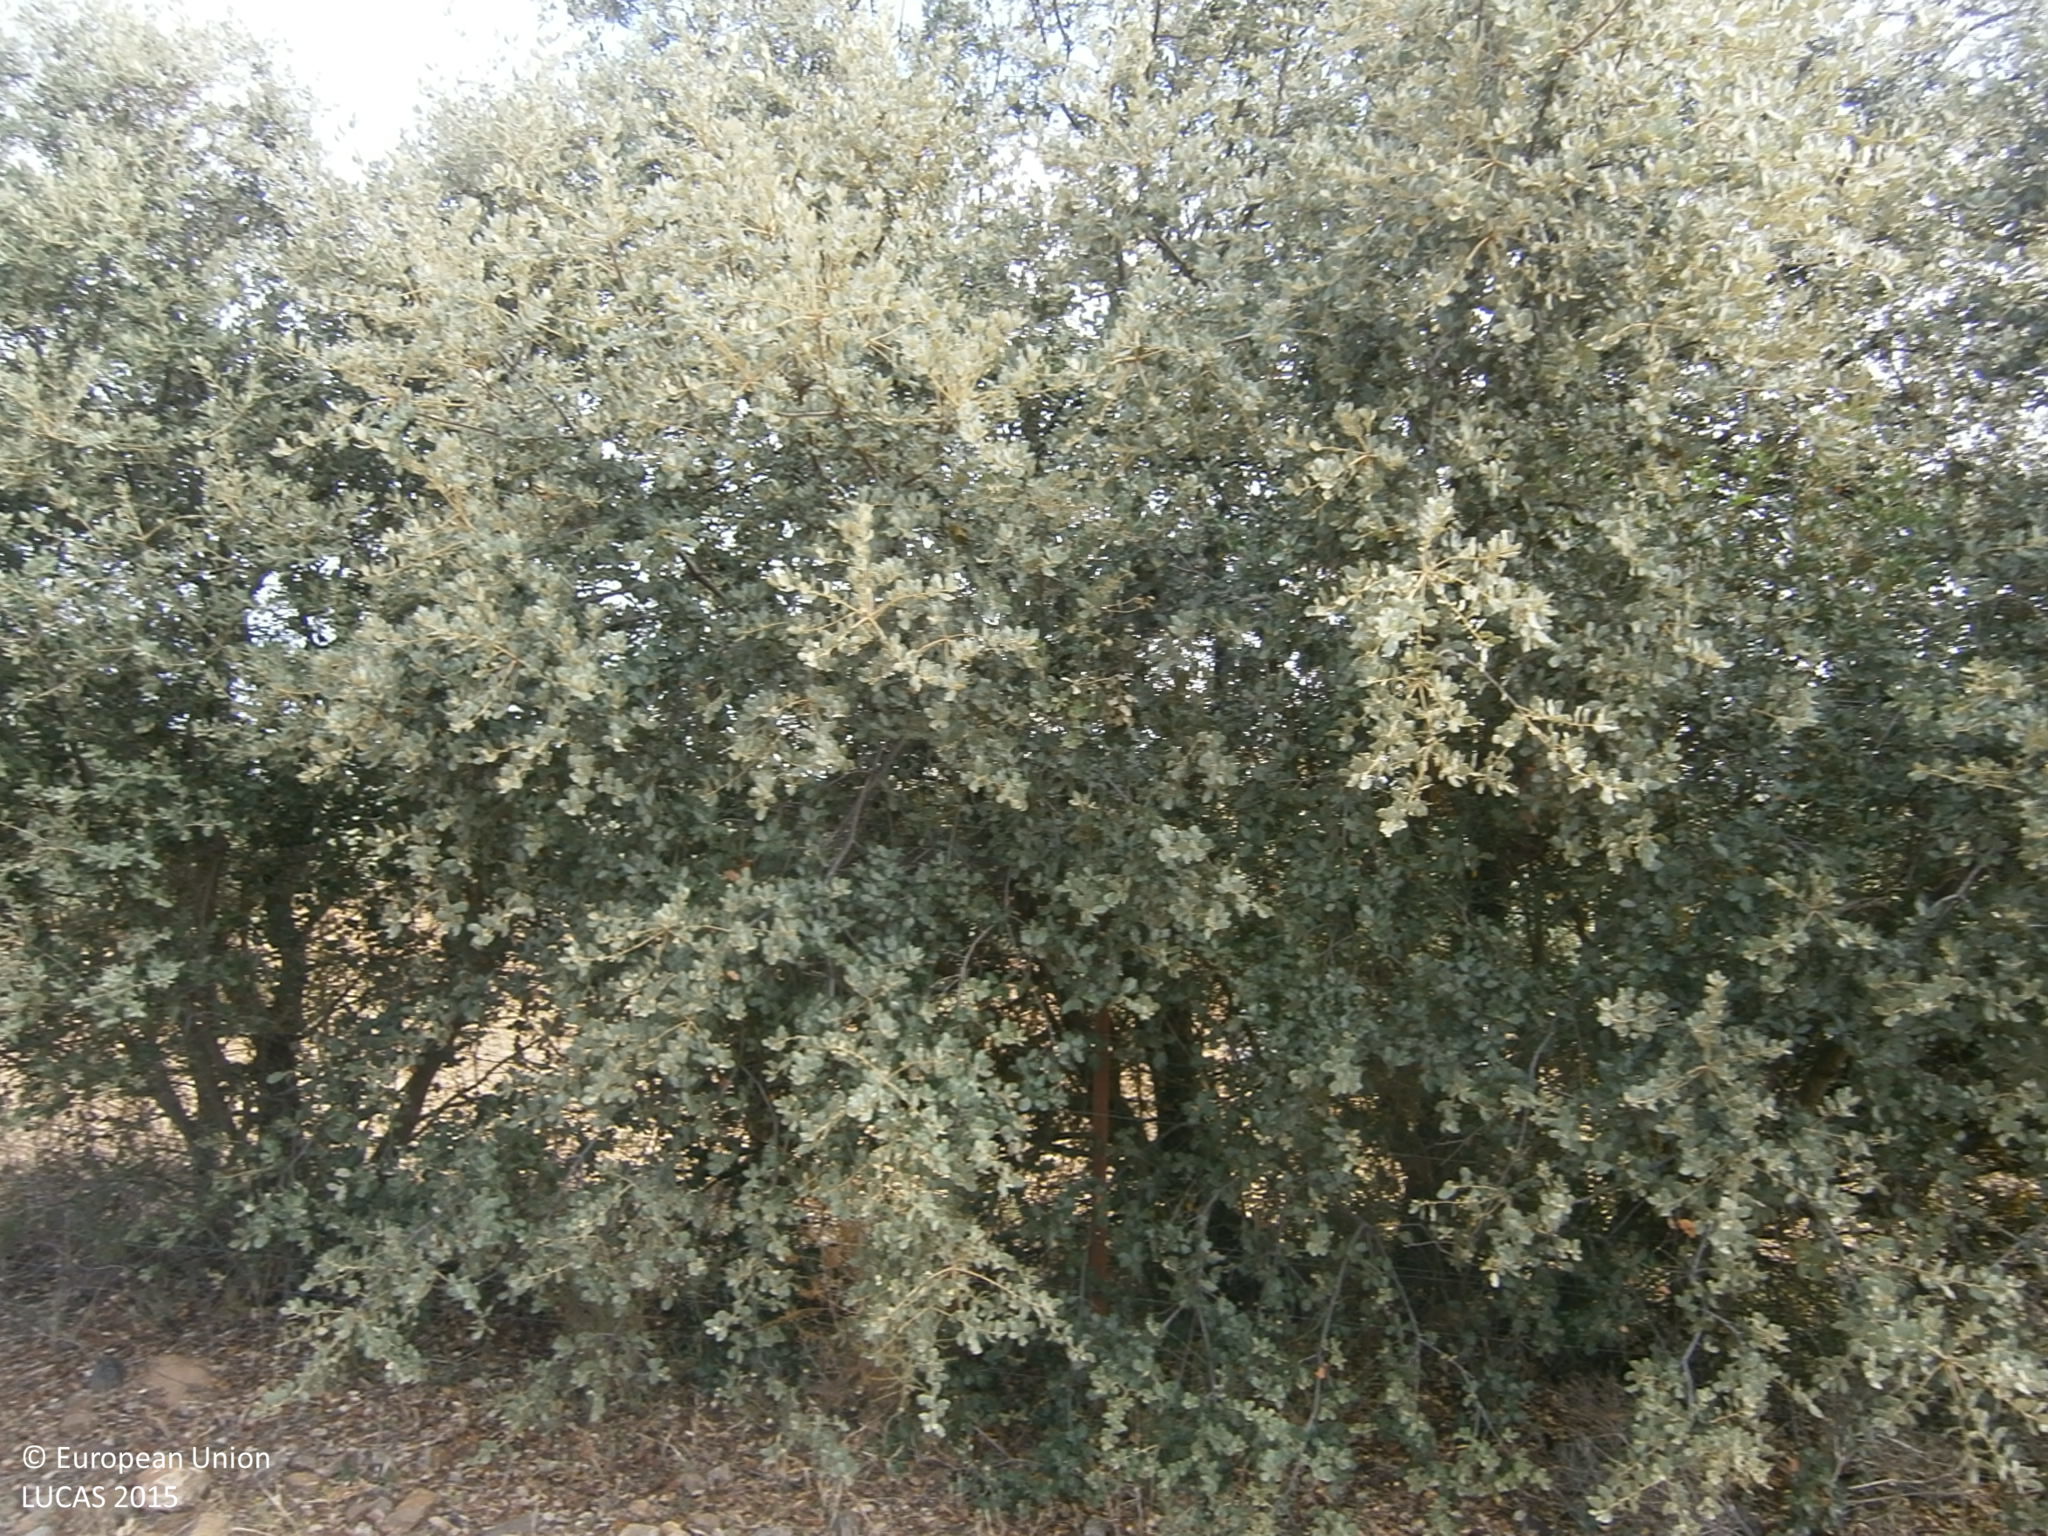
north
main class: Cropland
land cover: Olive groves
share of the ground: 10 - 25 %
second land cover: Spontaneously vegetated surfaces
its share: 50 - 75 %
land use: Agriculture (excluding fallow land and kitchen gardens)
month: June
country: ES
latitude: 38.6368
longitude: -6.8235
